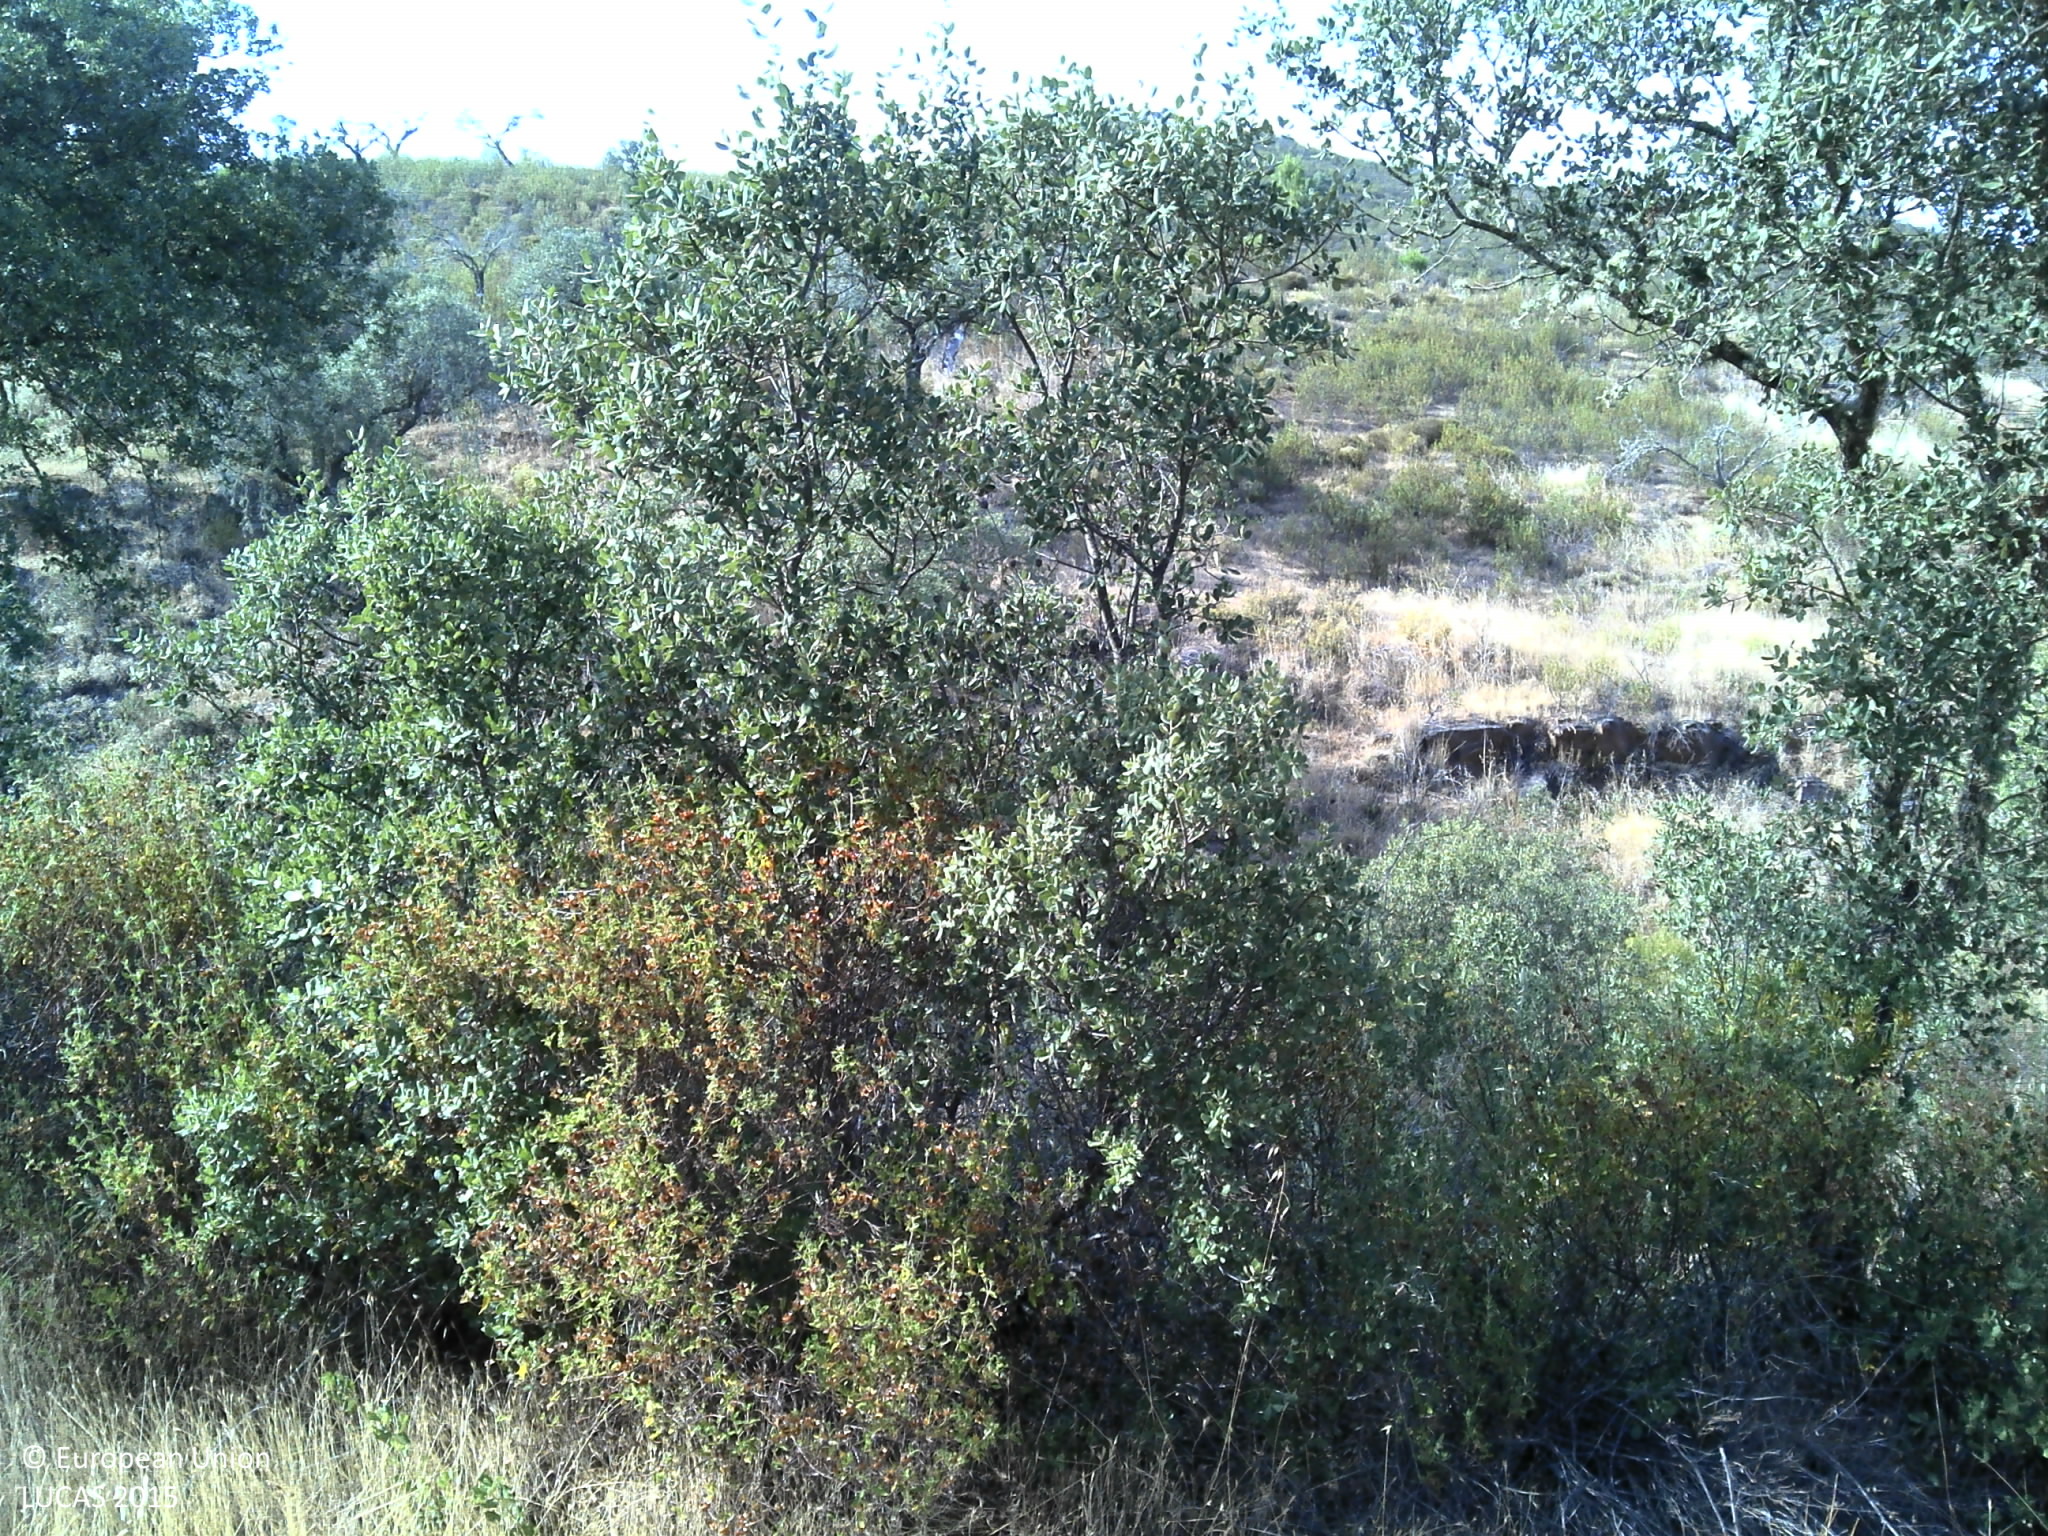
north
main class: Woodland
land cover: Broadleaved woodland
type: broadleaved evergreen forest
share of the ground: 25 - 50 %
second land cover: Shrubland without tree cover
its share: 50 - 75 %
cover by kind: shrubs 50 %, broadleaved forest trees 45 %, herbaceous plants 5 %
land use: Forestry
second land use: Agriculture (excluding fallow land and kitchen gardens)
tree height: < 5 m
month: June
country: PT
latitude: 37.7113
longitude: -7.4474
